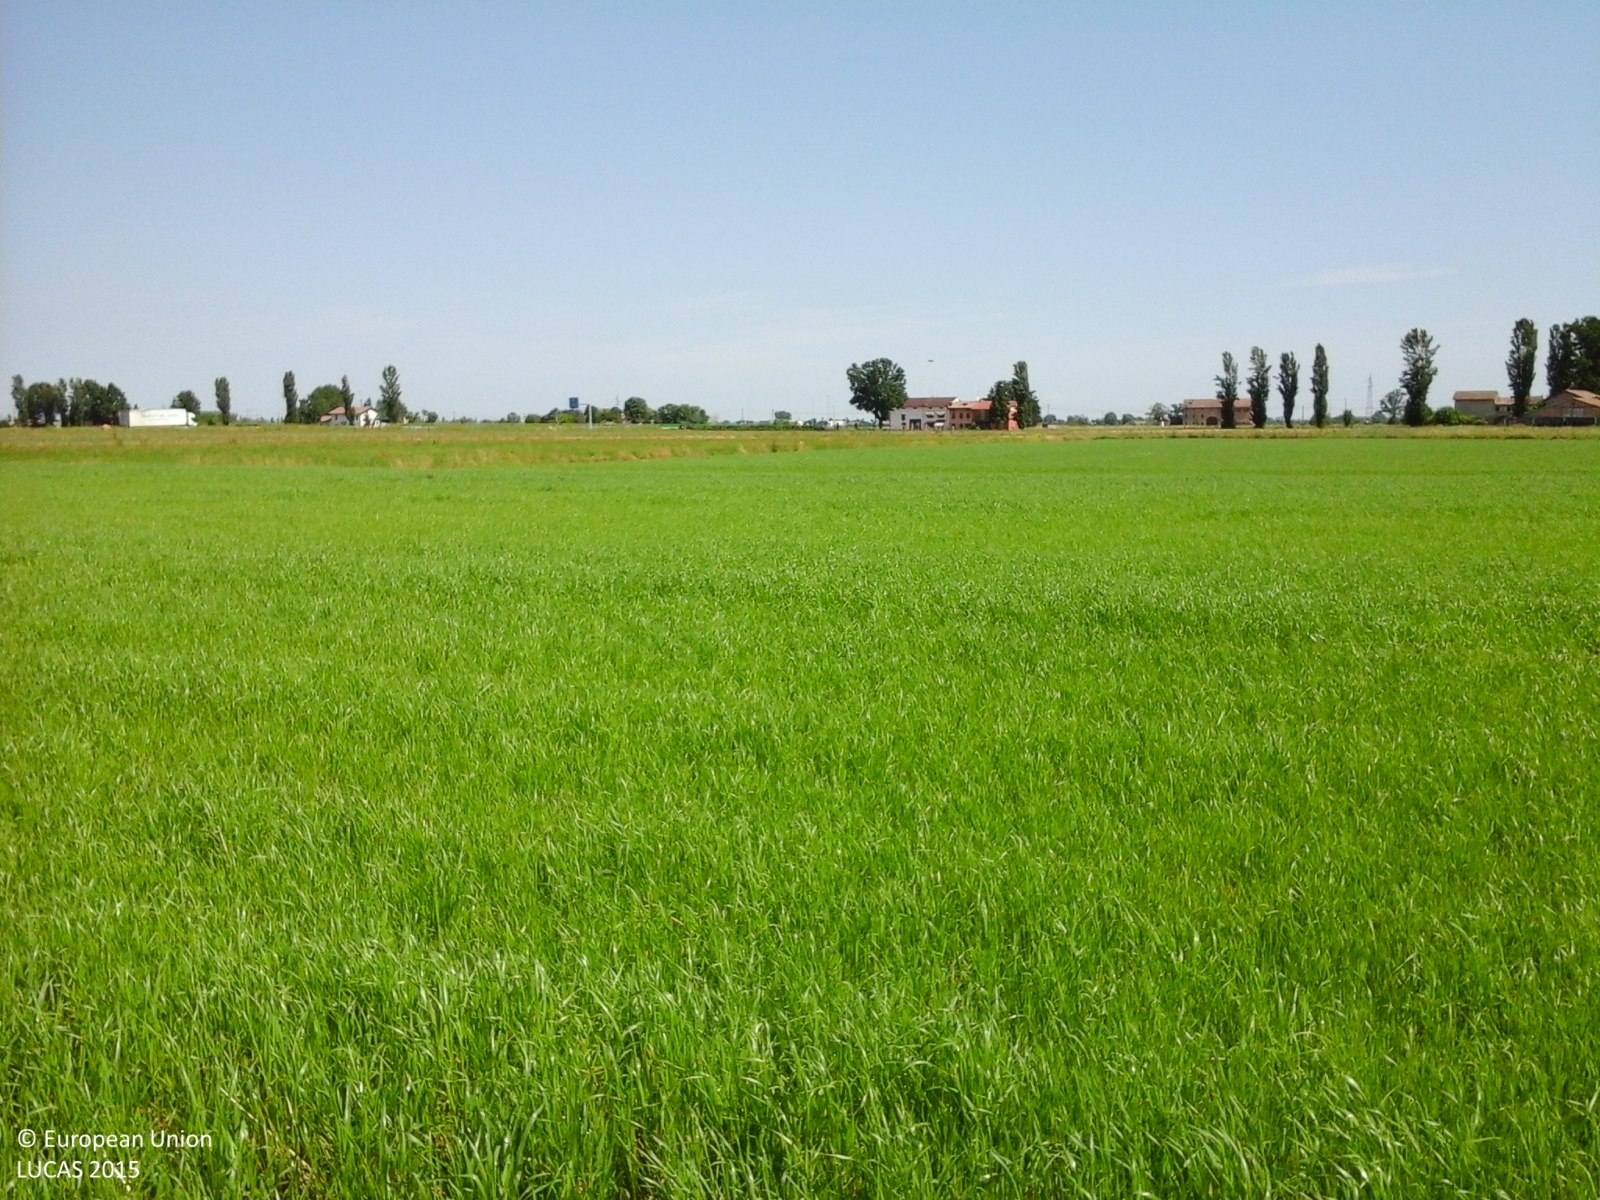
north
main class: Cropland
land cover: Temporary grasslands
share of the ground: > 75 %
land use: Agriculture (excluding fallow land and kitchen gardens)
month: May
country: IT
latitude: 44.8171
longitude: 10.6941
